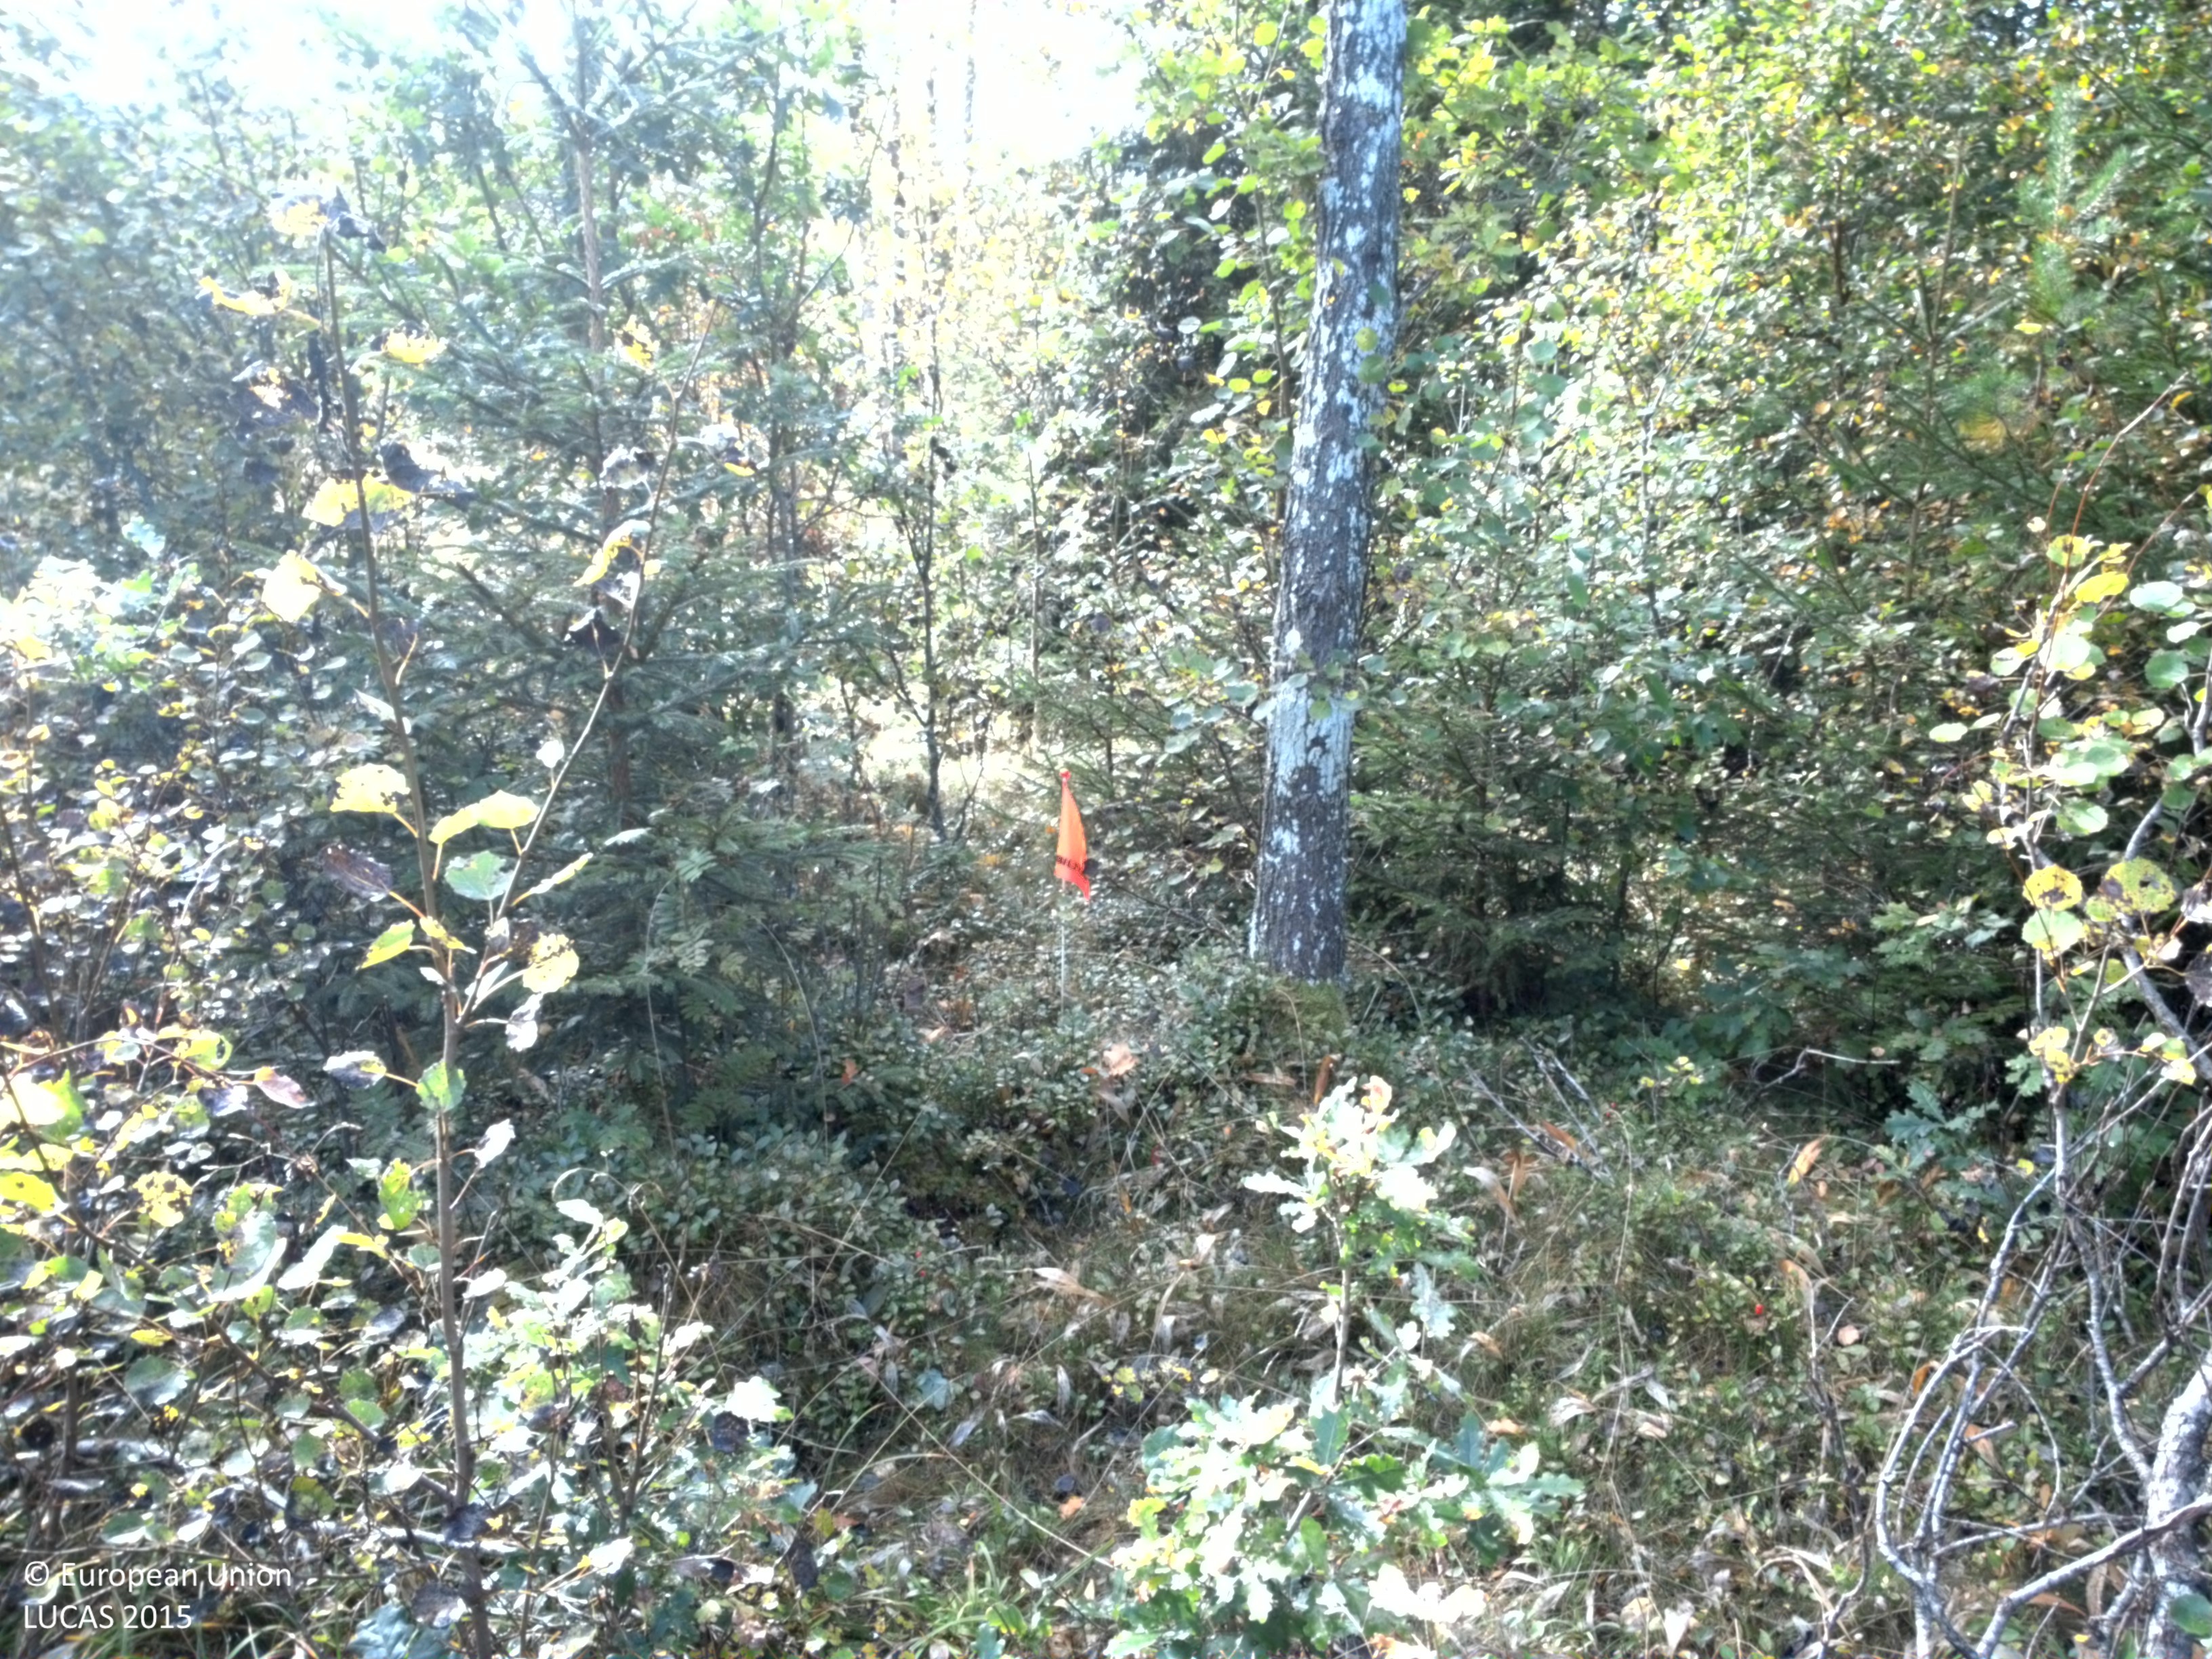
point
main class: Woodland
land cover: Broadleaved woodland
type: hemiboreal forest and nemoral coniferous forest and mixed broadleaved-coniferous forest
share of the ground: > 75 %
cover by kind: broadleaved forest trees 80 %, herbaceous plants 15 %, coniferous forest trees 5 %
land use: Forestry
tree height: > 5 m
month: September
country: SE
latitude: 58.0391
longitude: 13.1284
